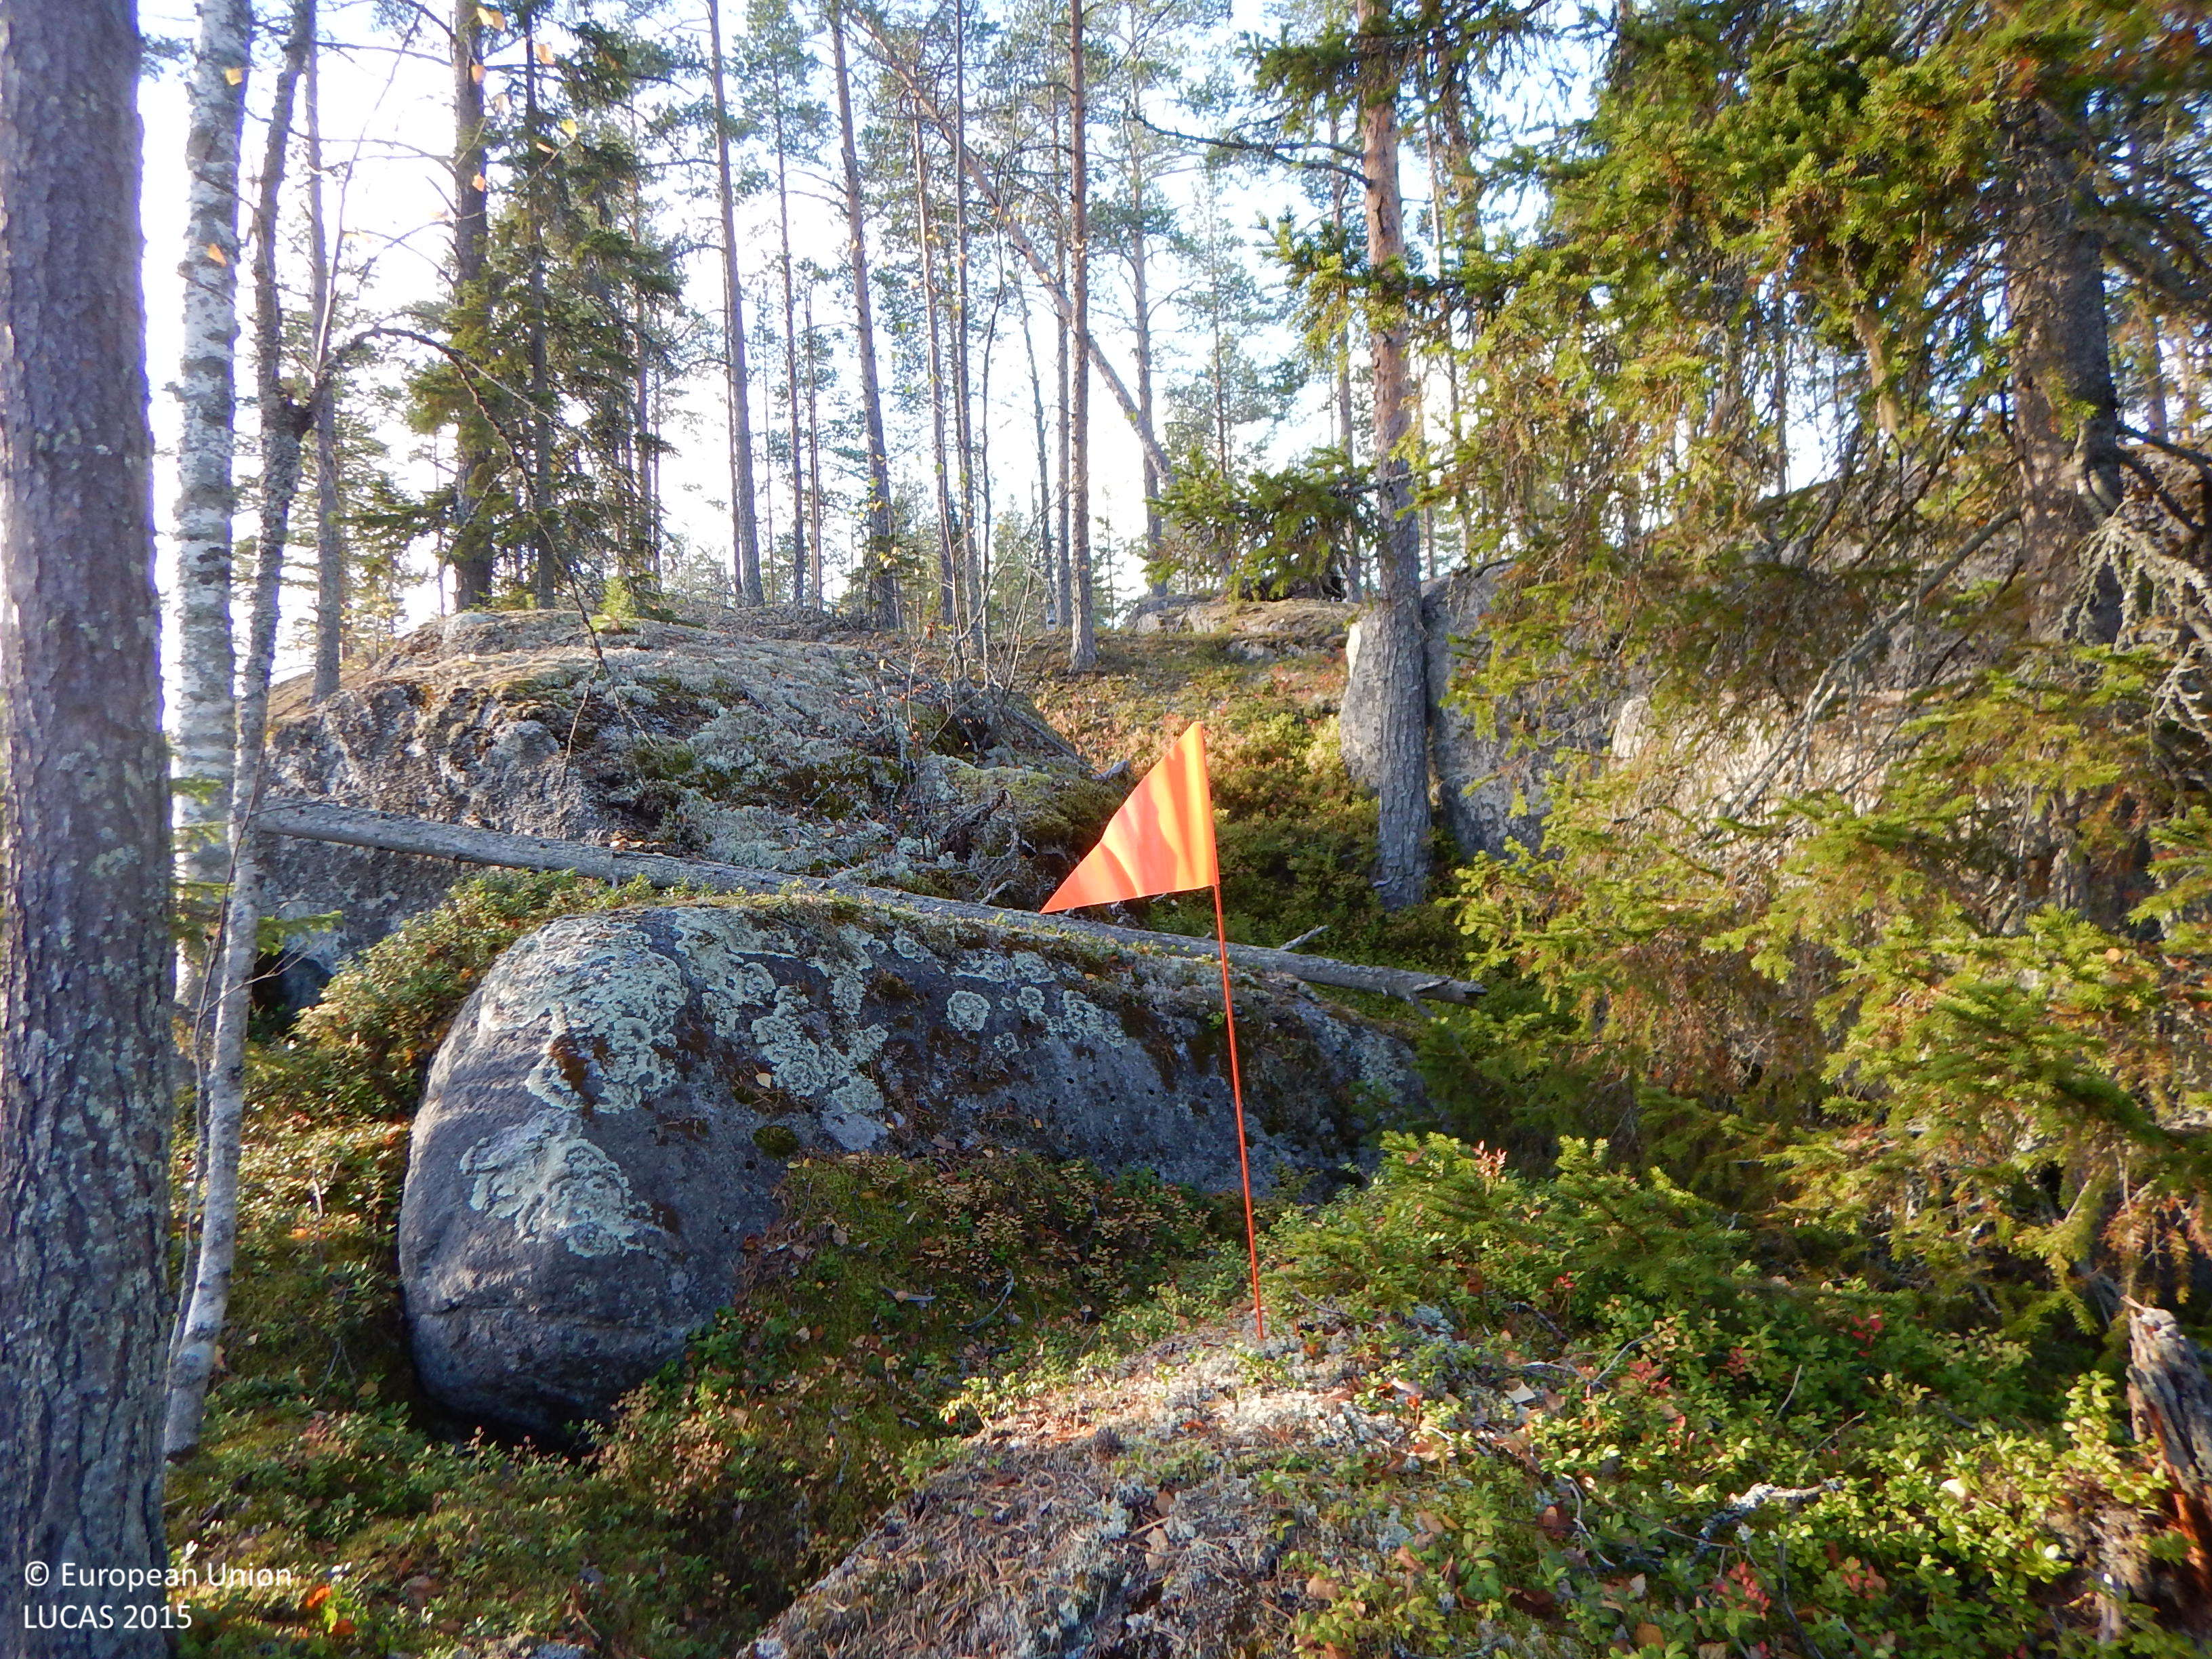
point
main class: Woodland
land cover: Other coniferous woodland
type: boreal forest
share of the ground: 50 - 75 %
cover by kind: coniferous forest trees 50 %, shrubs 20 %, lichens and mosses 20 %, herbaceous plants 5 %, consolidated bare surface 5 %
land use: Forestry
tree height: > 5 m
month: October
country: SE
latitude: 64.9167
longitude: 20.9057
